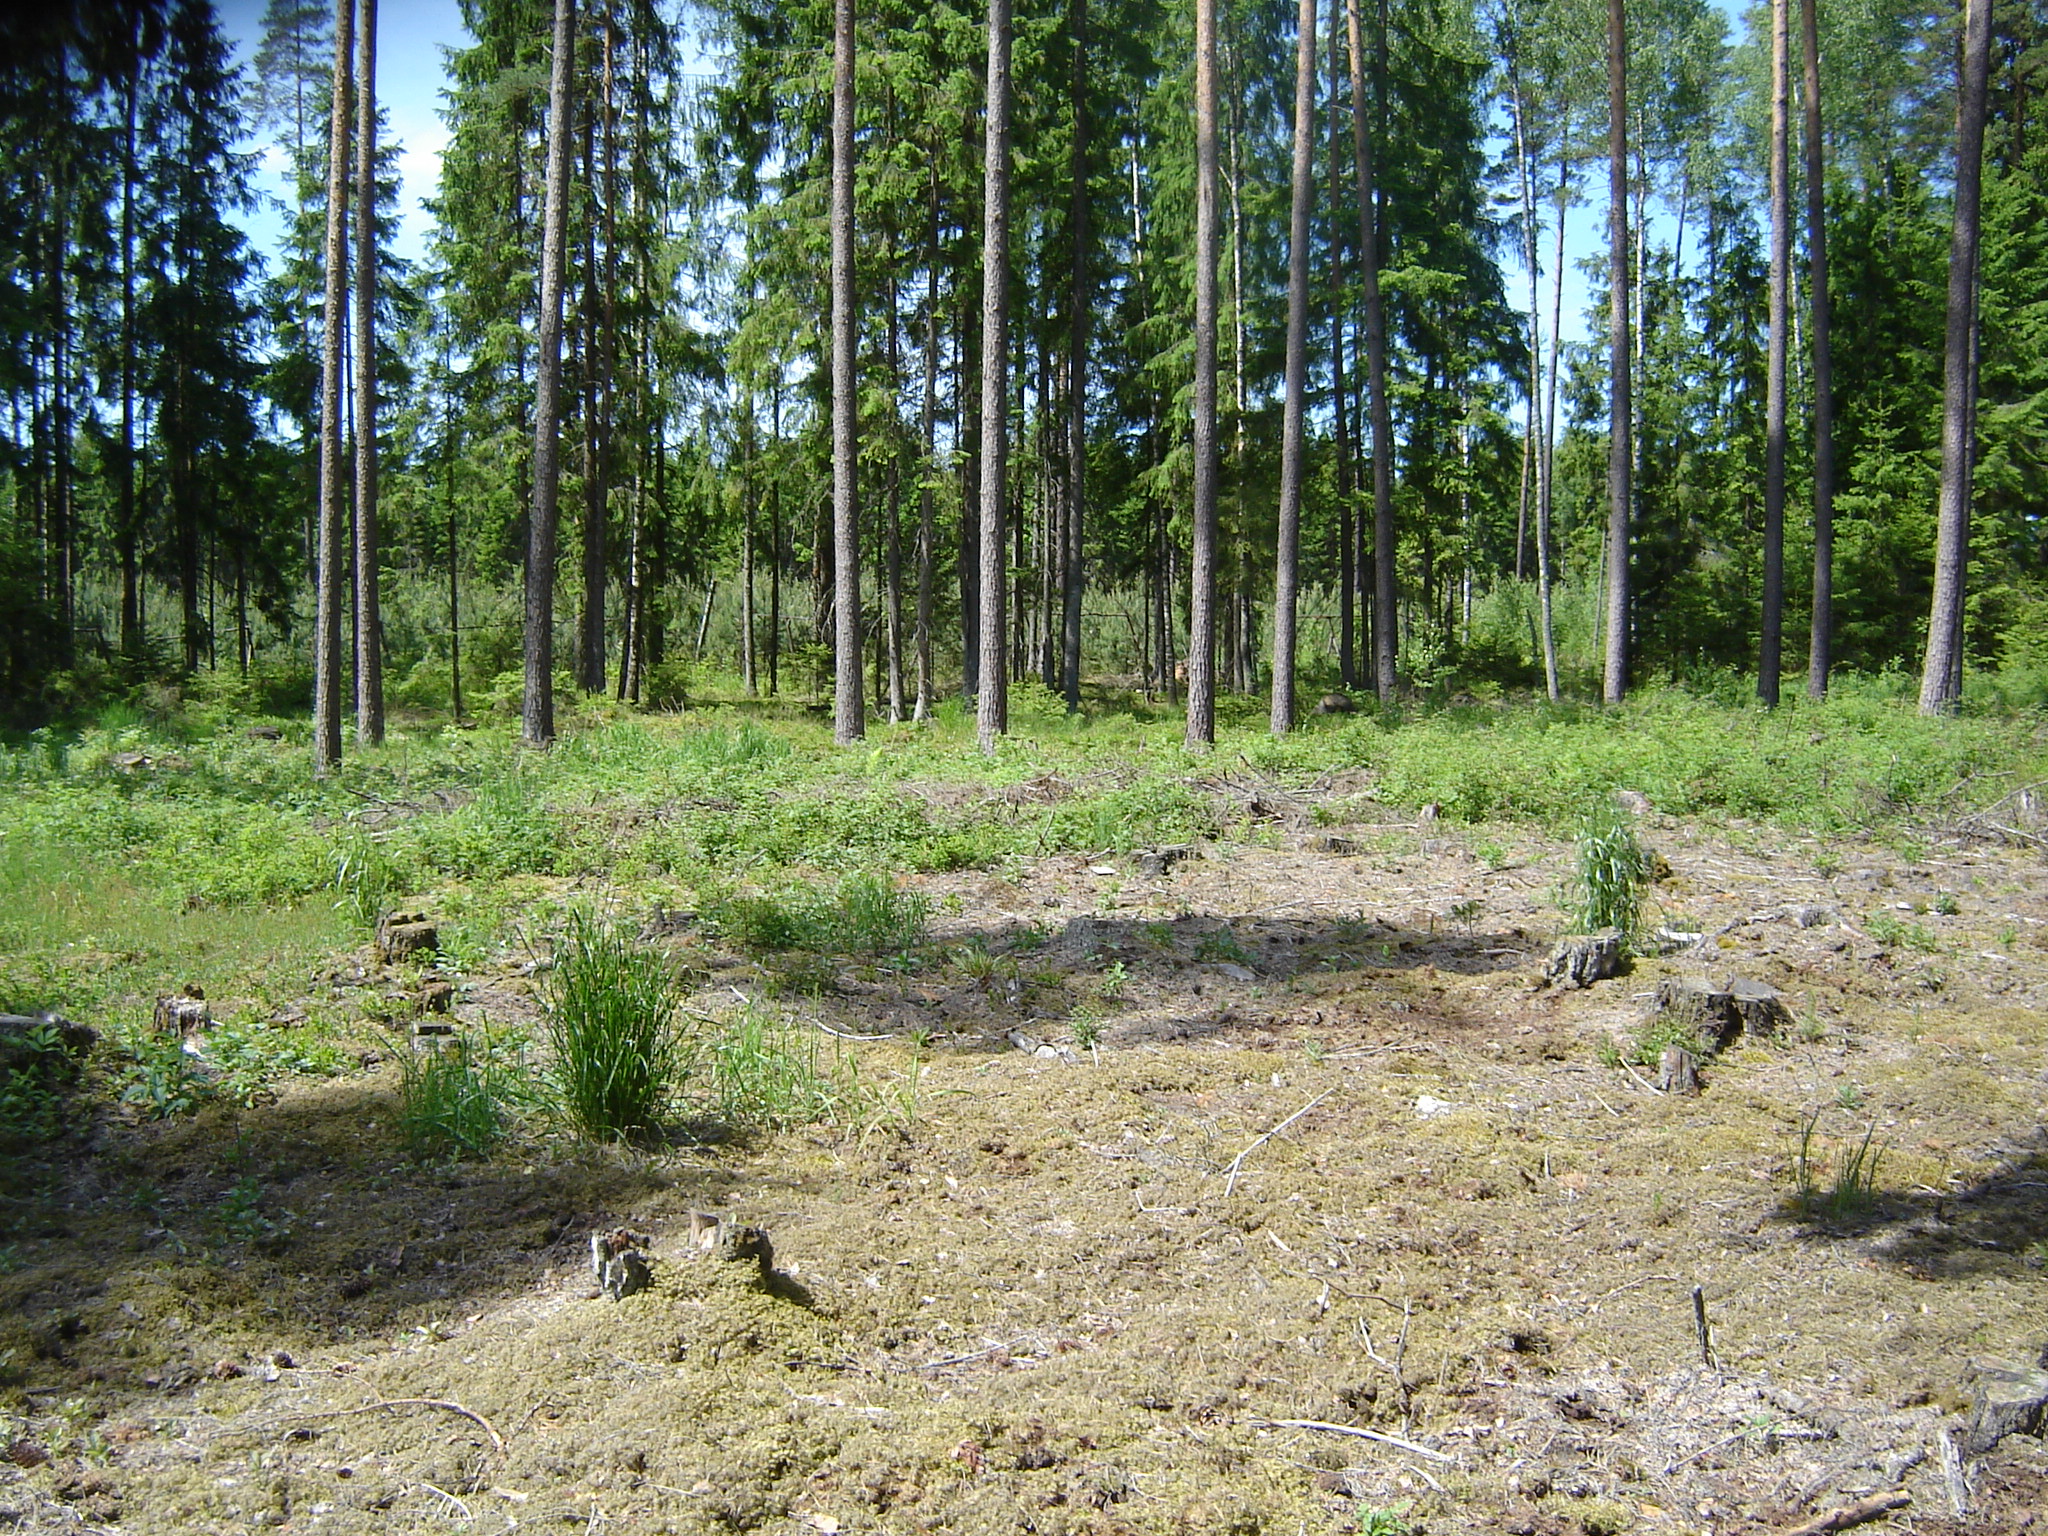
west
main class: Woodland
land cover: Pine dominated coniferous woodland
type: hemiboreal forest and nemoral coniferous forest and mixed broadleaved-coniferous forest
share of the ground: 50 - 75 %
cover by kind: coniferous forest trees 50 %, lichens and mosses 30 %, shrubs 10 %, herbaceous plants 10 %
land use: Forestry
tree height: > 5 m
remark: Clear cut
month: June
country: LT
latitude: 55.6807
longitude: 25.1763
